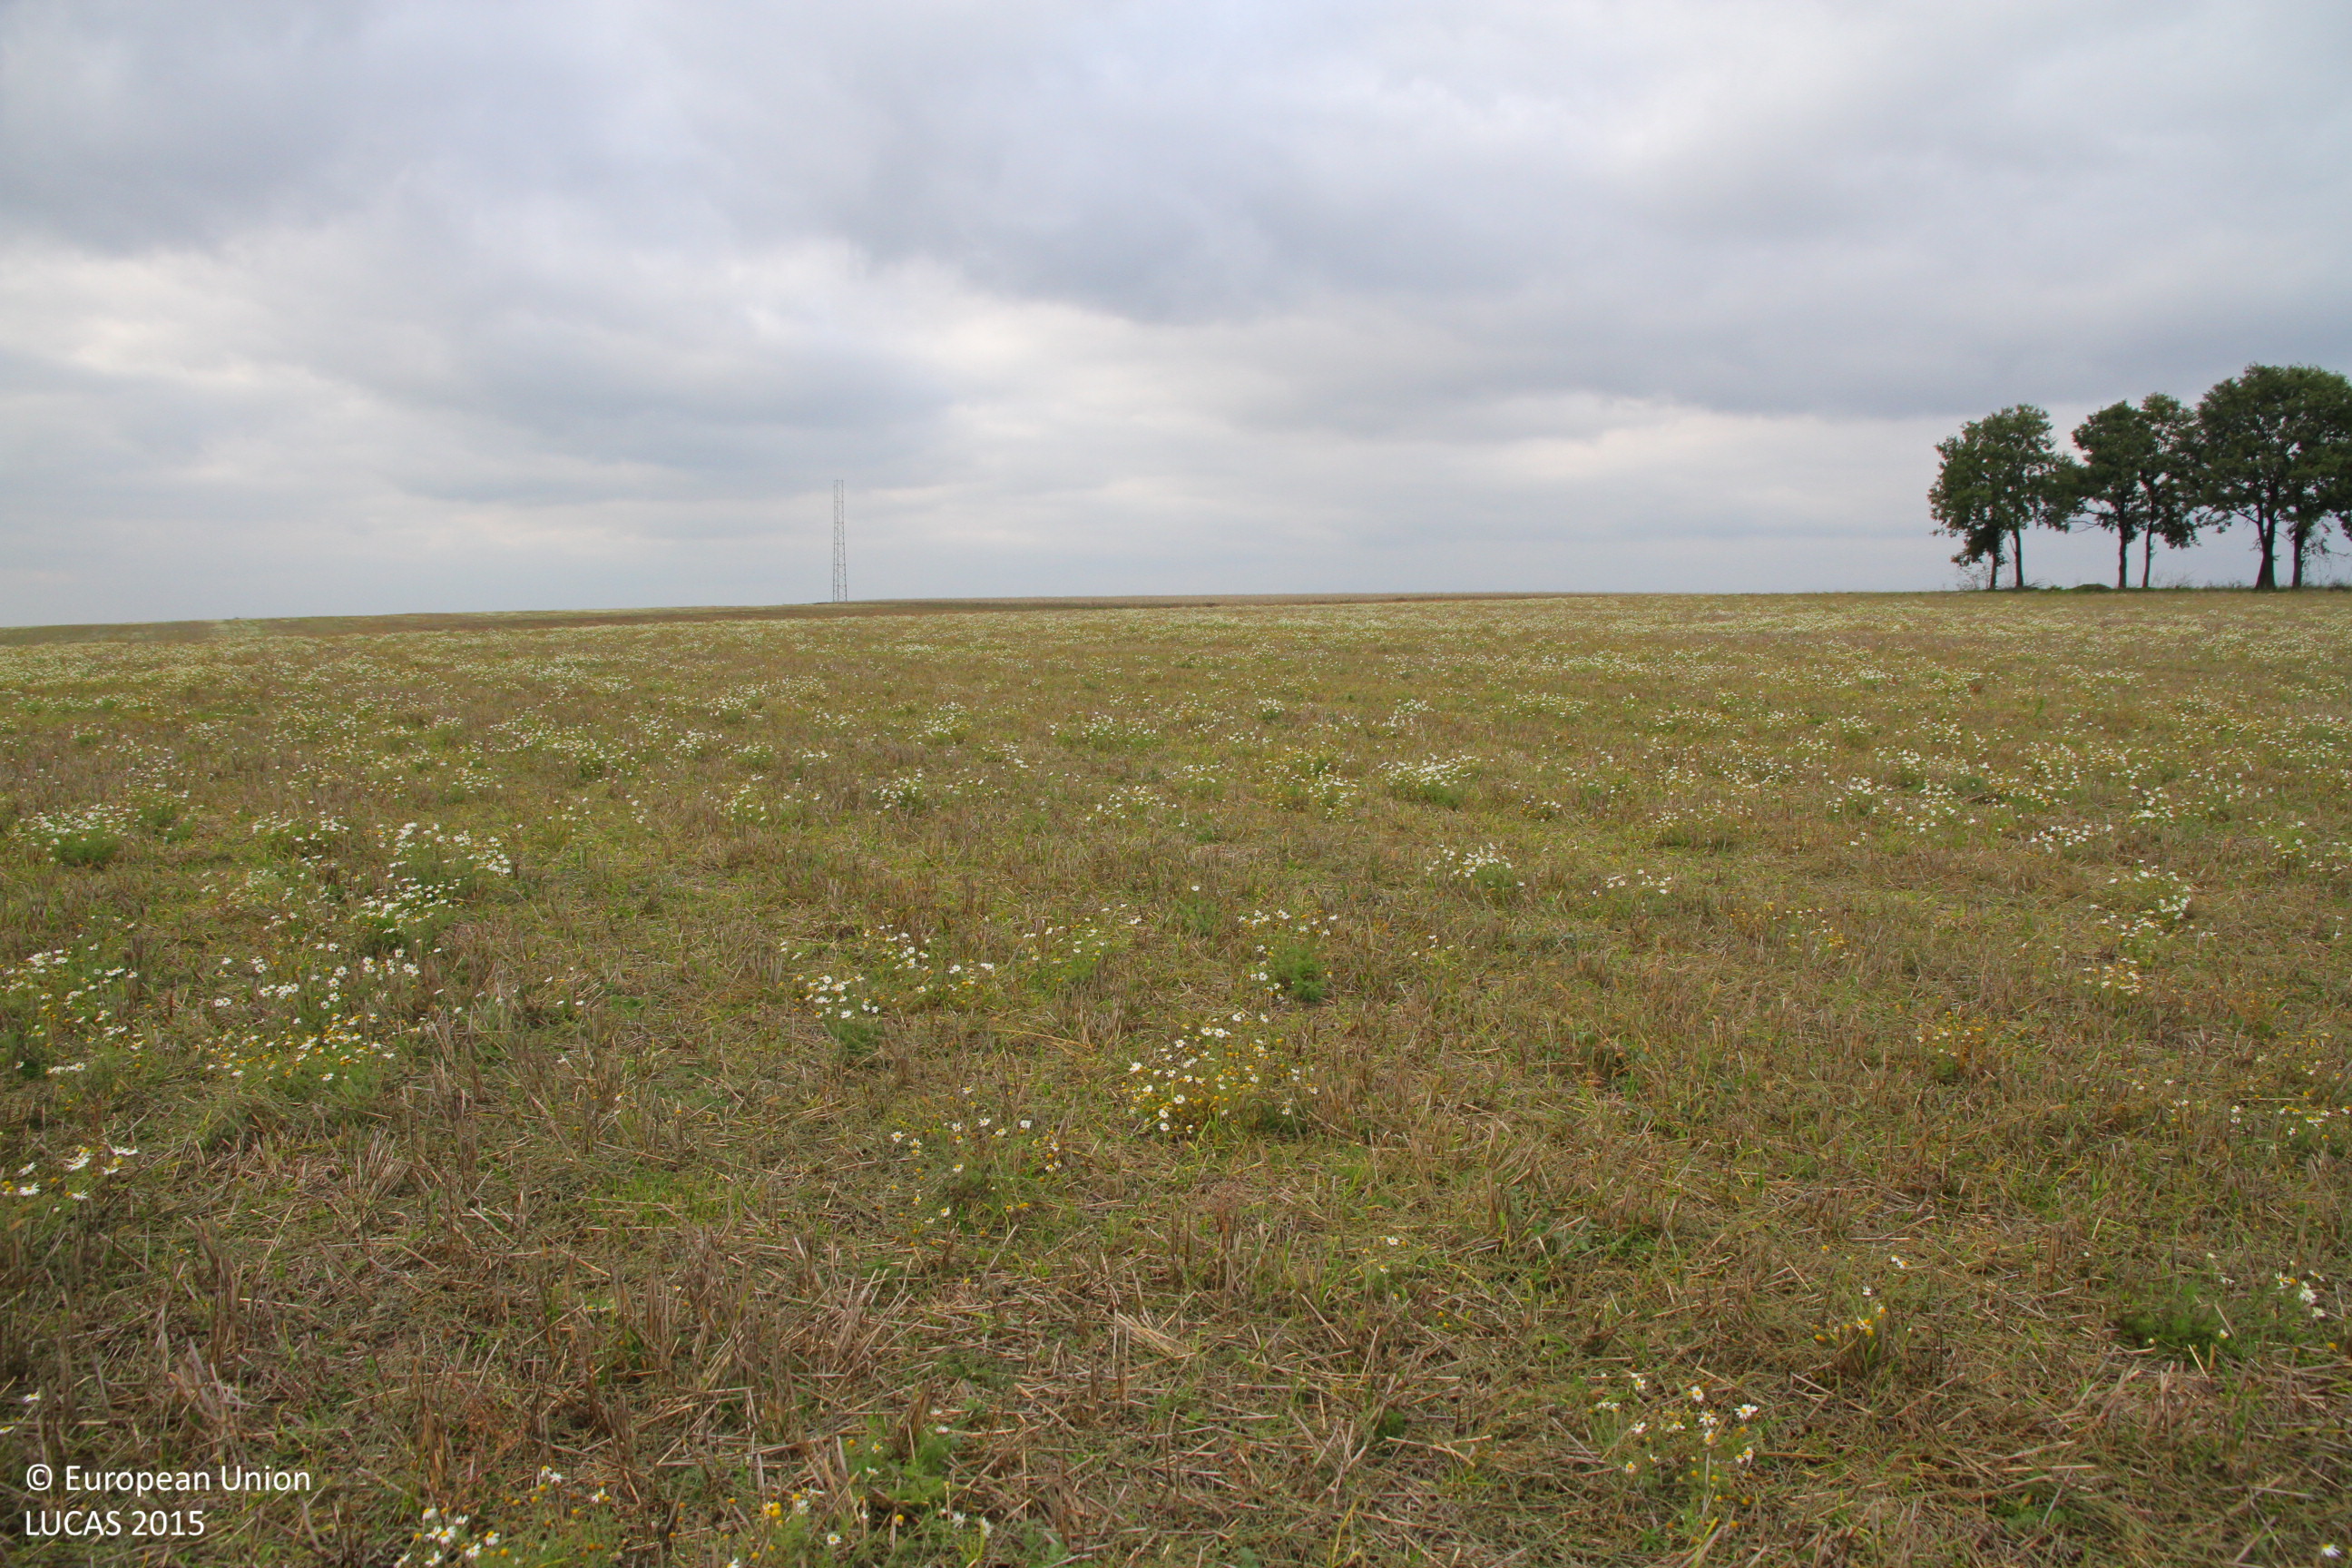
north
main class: Cropland
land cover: Common wheat
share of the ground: < 10 %
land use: Agriculture (excluding fallow land and kitchen gardens)
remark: Harvested field
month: October
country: BG
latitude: 43.6054
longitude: 26.9542
